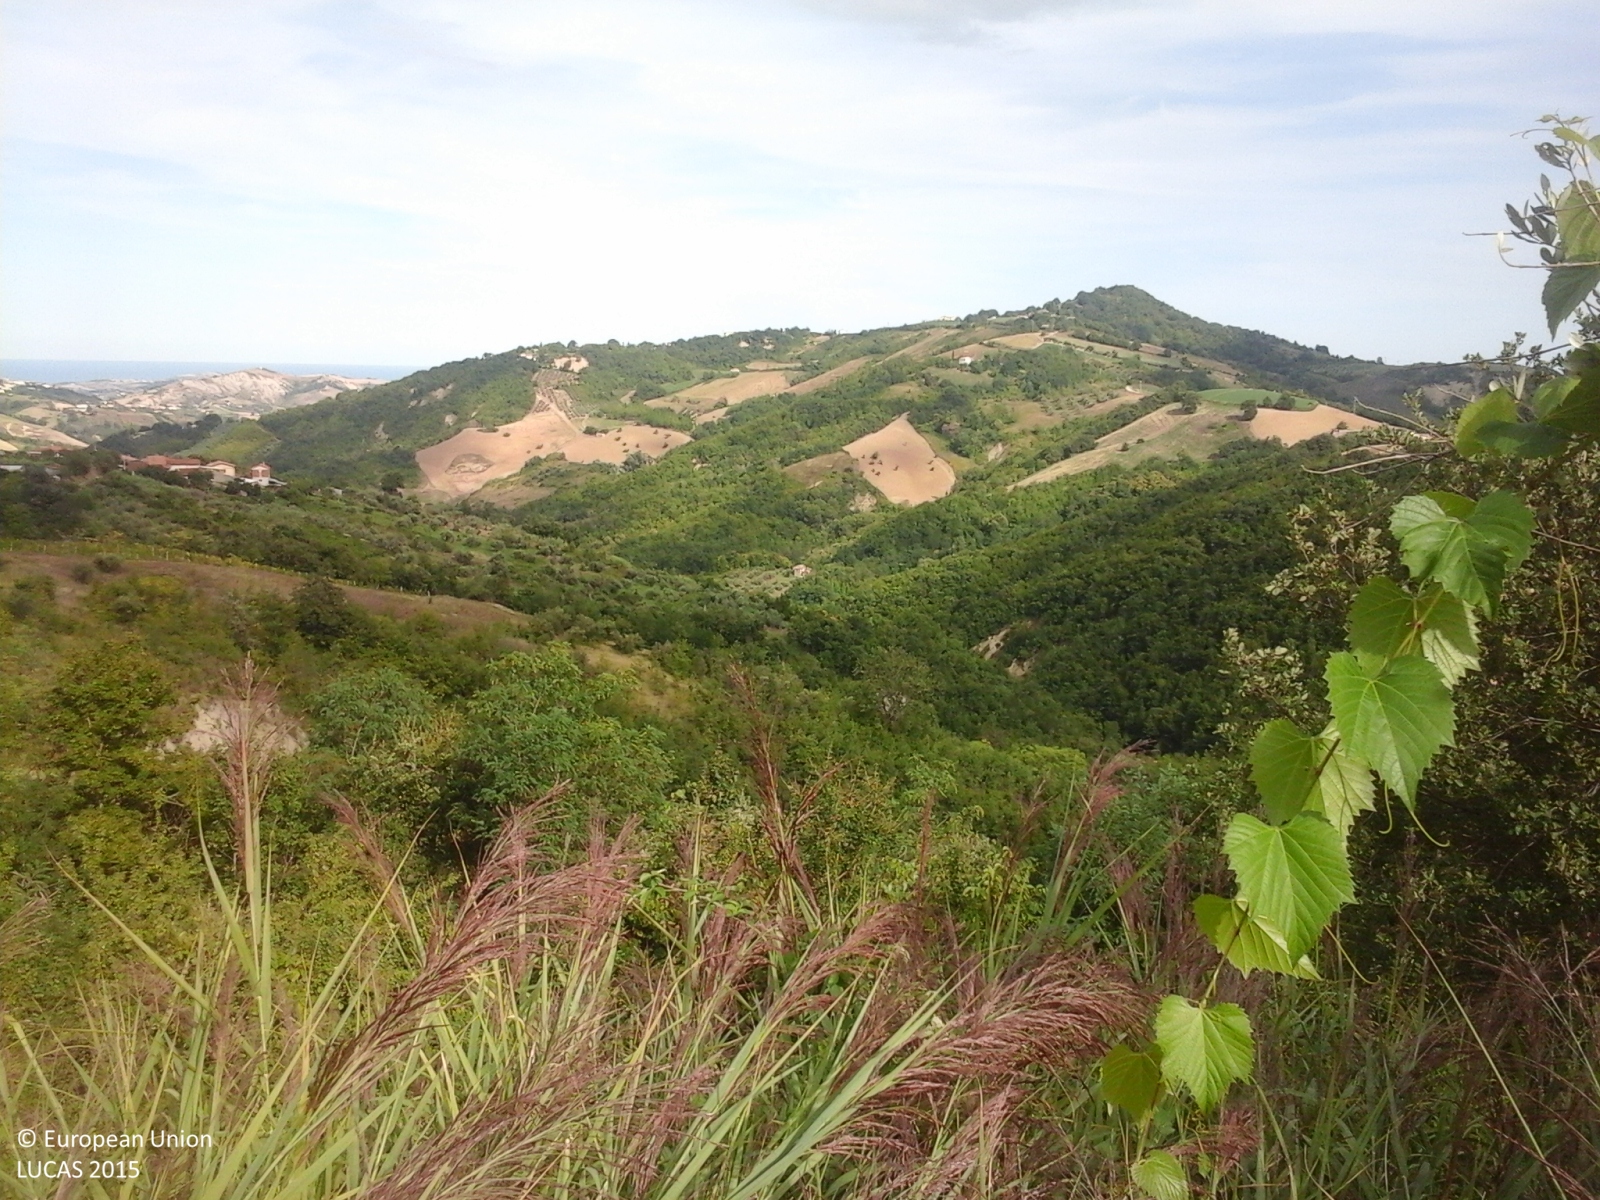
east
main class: Woodland
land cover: Broadleaved woodland
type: thermophilous deciduous forest
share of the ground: > 75 %
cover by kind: broadleaved forest trees 80 %, shrubs 10 %, herbaceous plants 10 %
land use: Semi-natural and natural areas not in use
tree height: > 5 m
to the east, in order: Broadleaved woodland; Shrubland with sparse tree cover; Broadleaved woodland; Shrubland with sparse tree cover
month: September
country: IT
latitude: 42.5646
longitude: 13.8014
